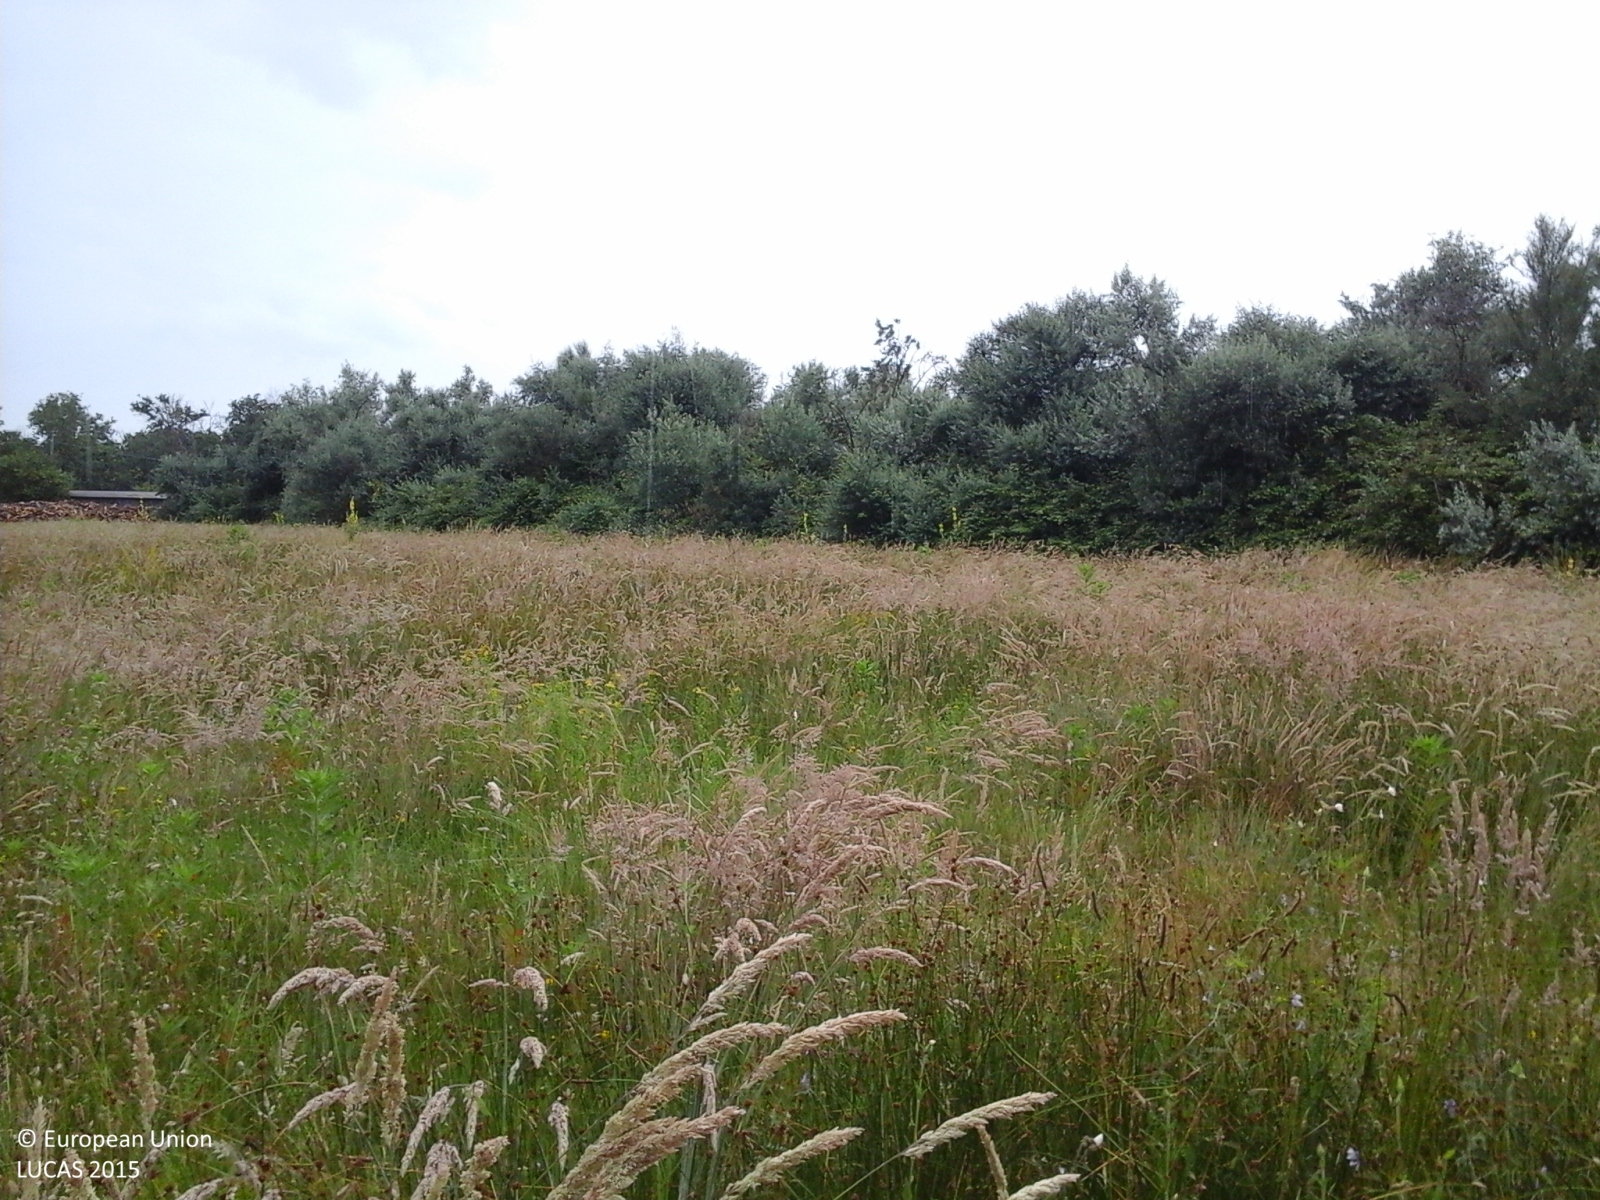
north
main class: Grassland
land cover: Grassland without tree/shrub cover
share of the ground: > 75 %
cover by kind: herbaceous plants 100 %
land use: Agriculture (excluding fallow land and kitchen gardens)
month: June
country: IT
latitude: 44.5968
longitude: 12.2505
